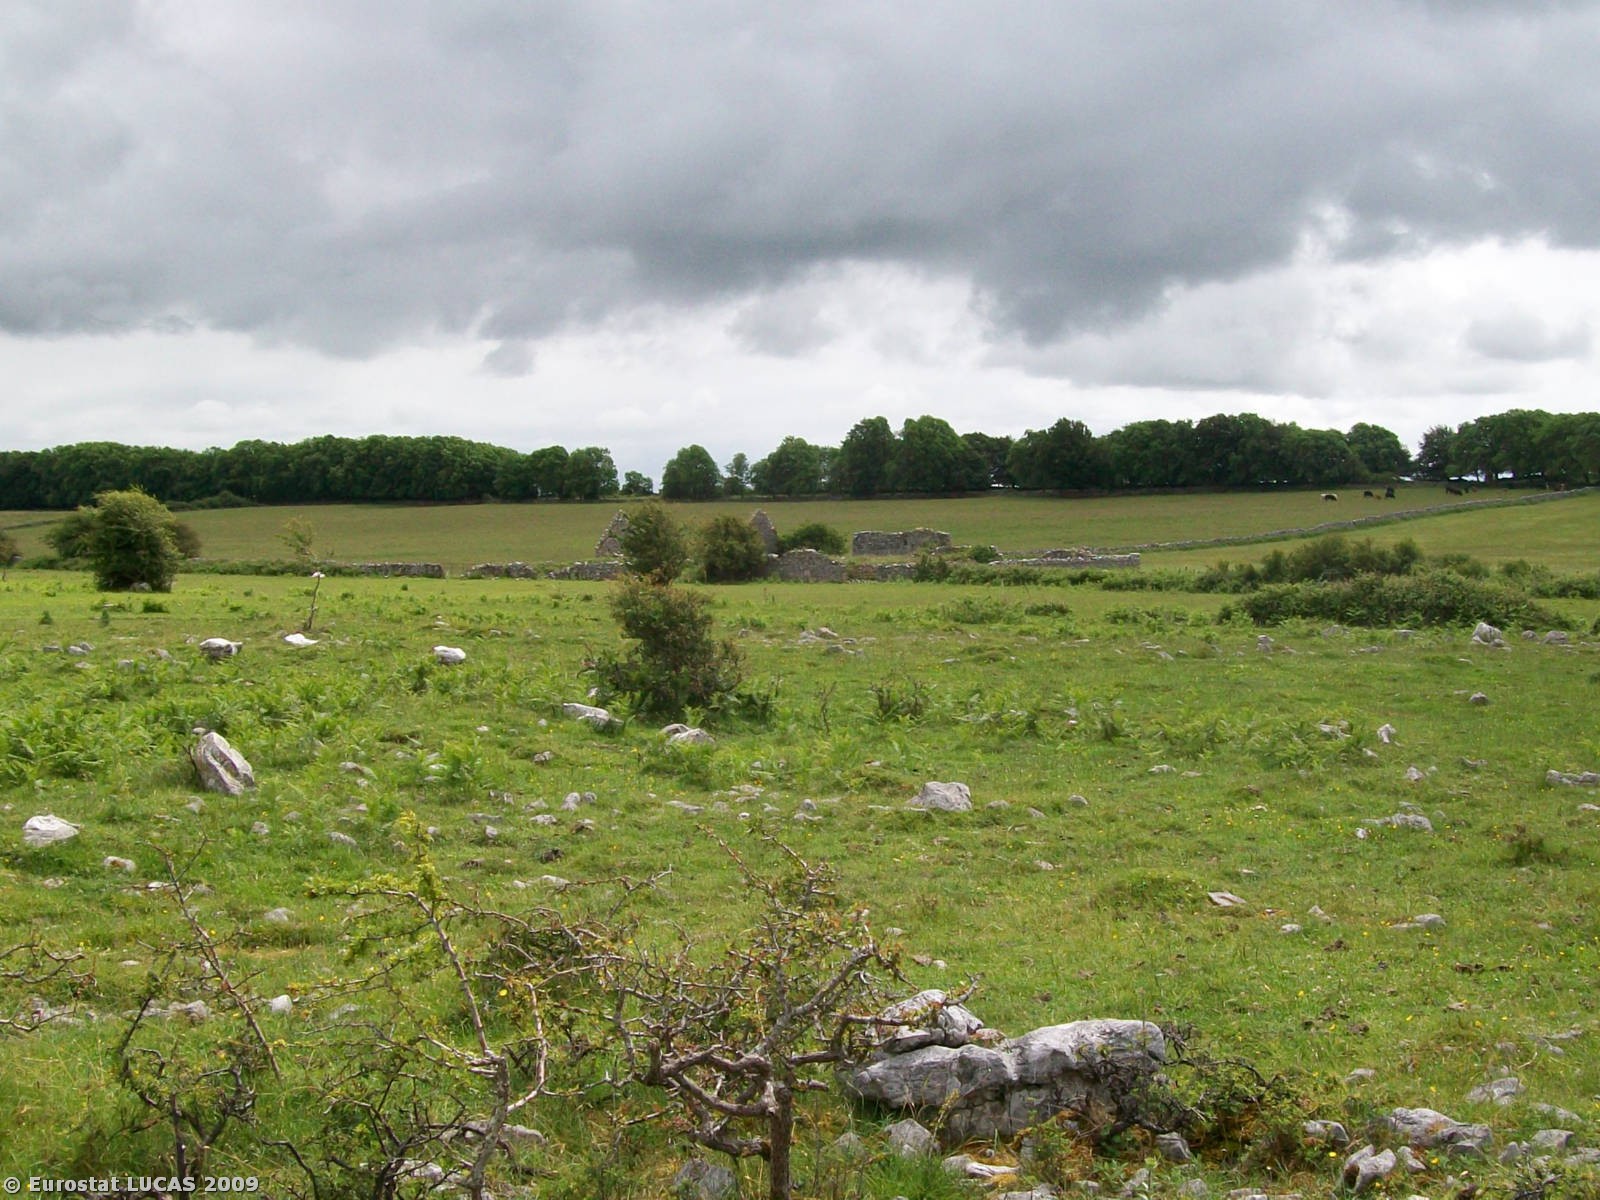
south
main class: Grassland
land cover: Grassland with sparse tree/shrub cover
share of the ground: > 75 %
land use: Agriculture (excluding fallow land and kitchen gardens)
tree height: < 5 m
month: June
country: IE
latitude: 53.3492
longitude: -8.8179
